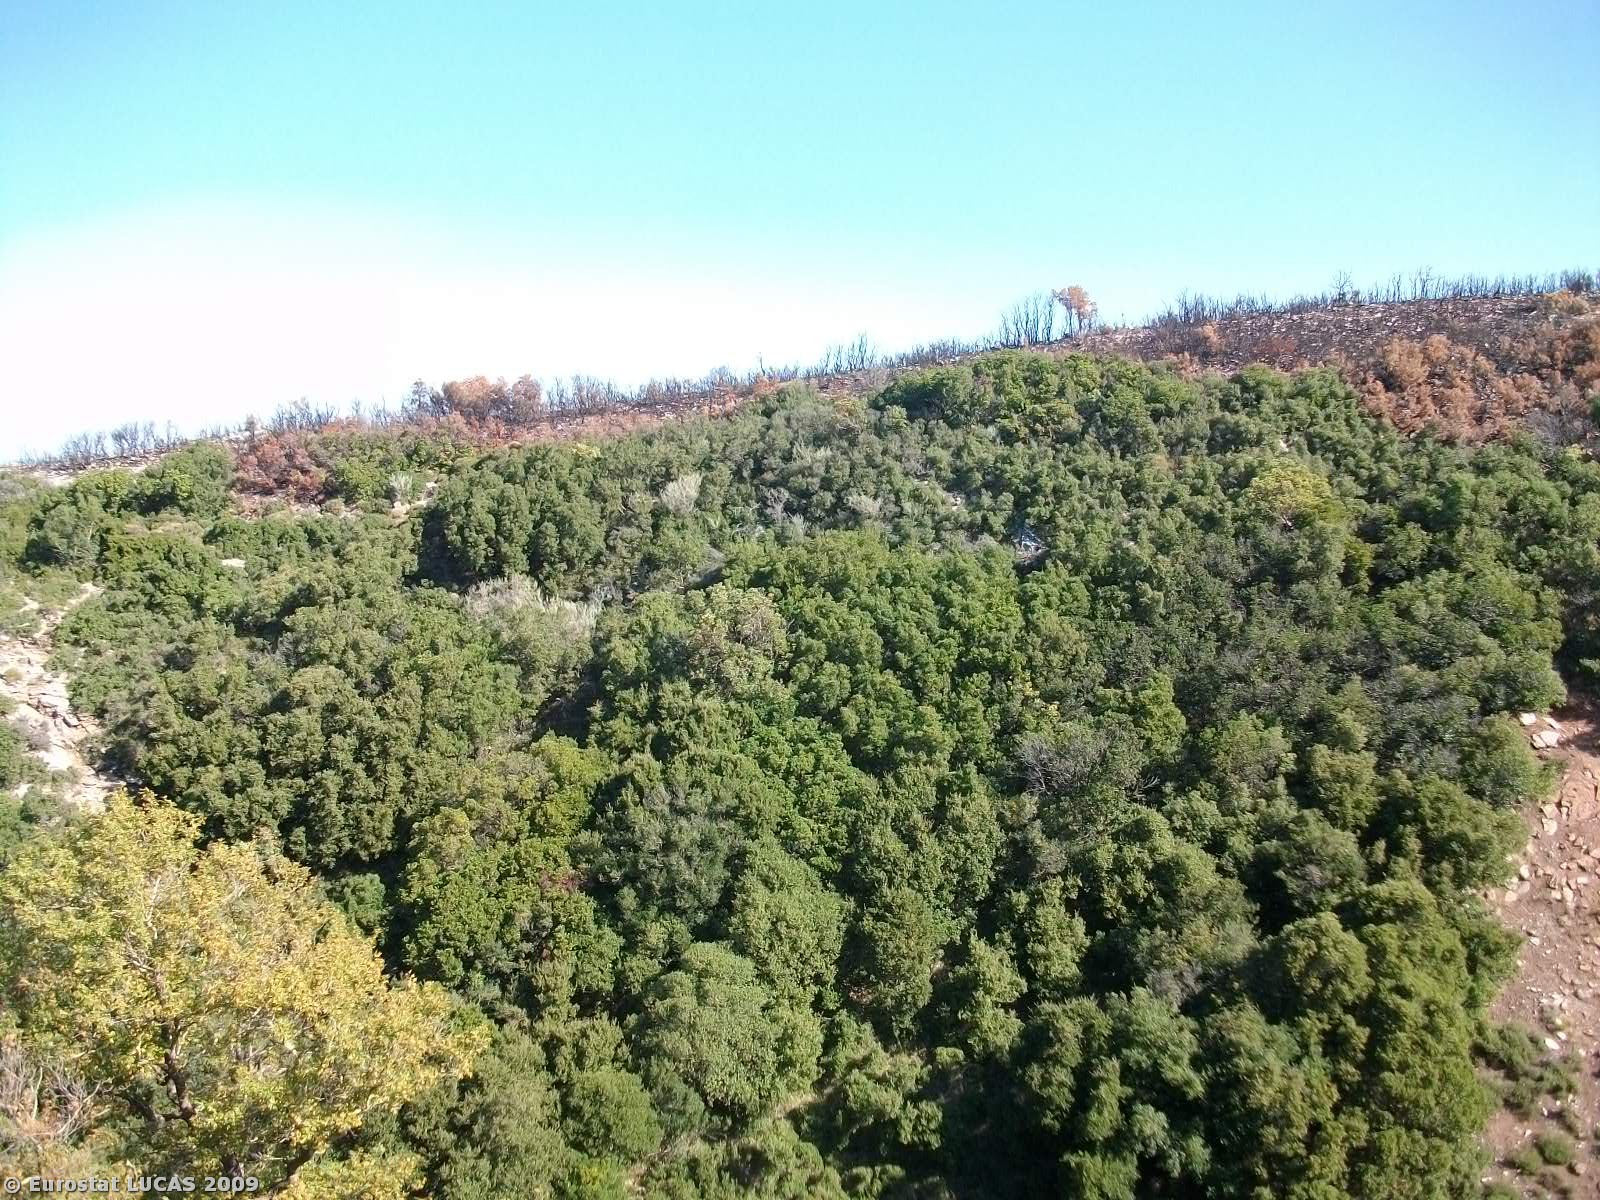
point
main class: Shrubland
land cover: Shrubland with sparse tree cover
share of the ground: > 75 %
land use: Unused
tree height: < 5 m
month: October
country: GR
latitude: 38.1685
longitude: 21.7574
